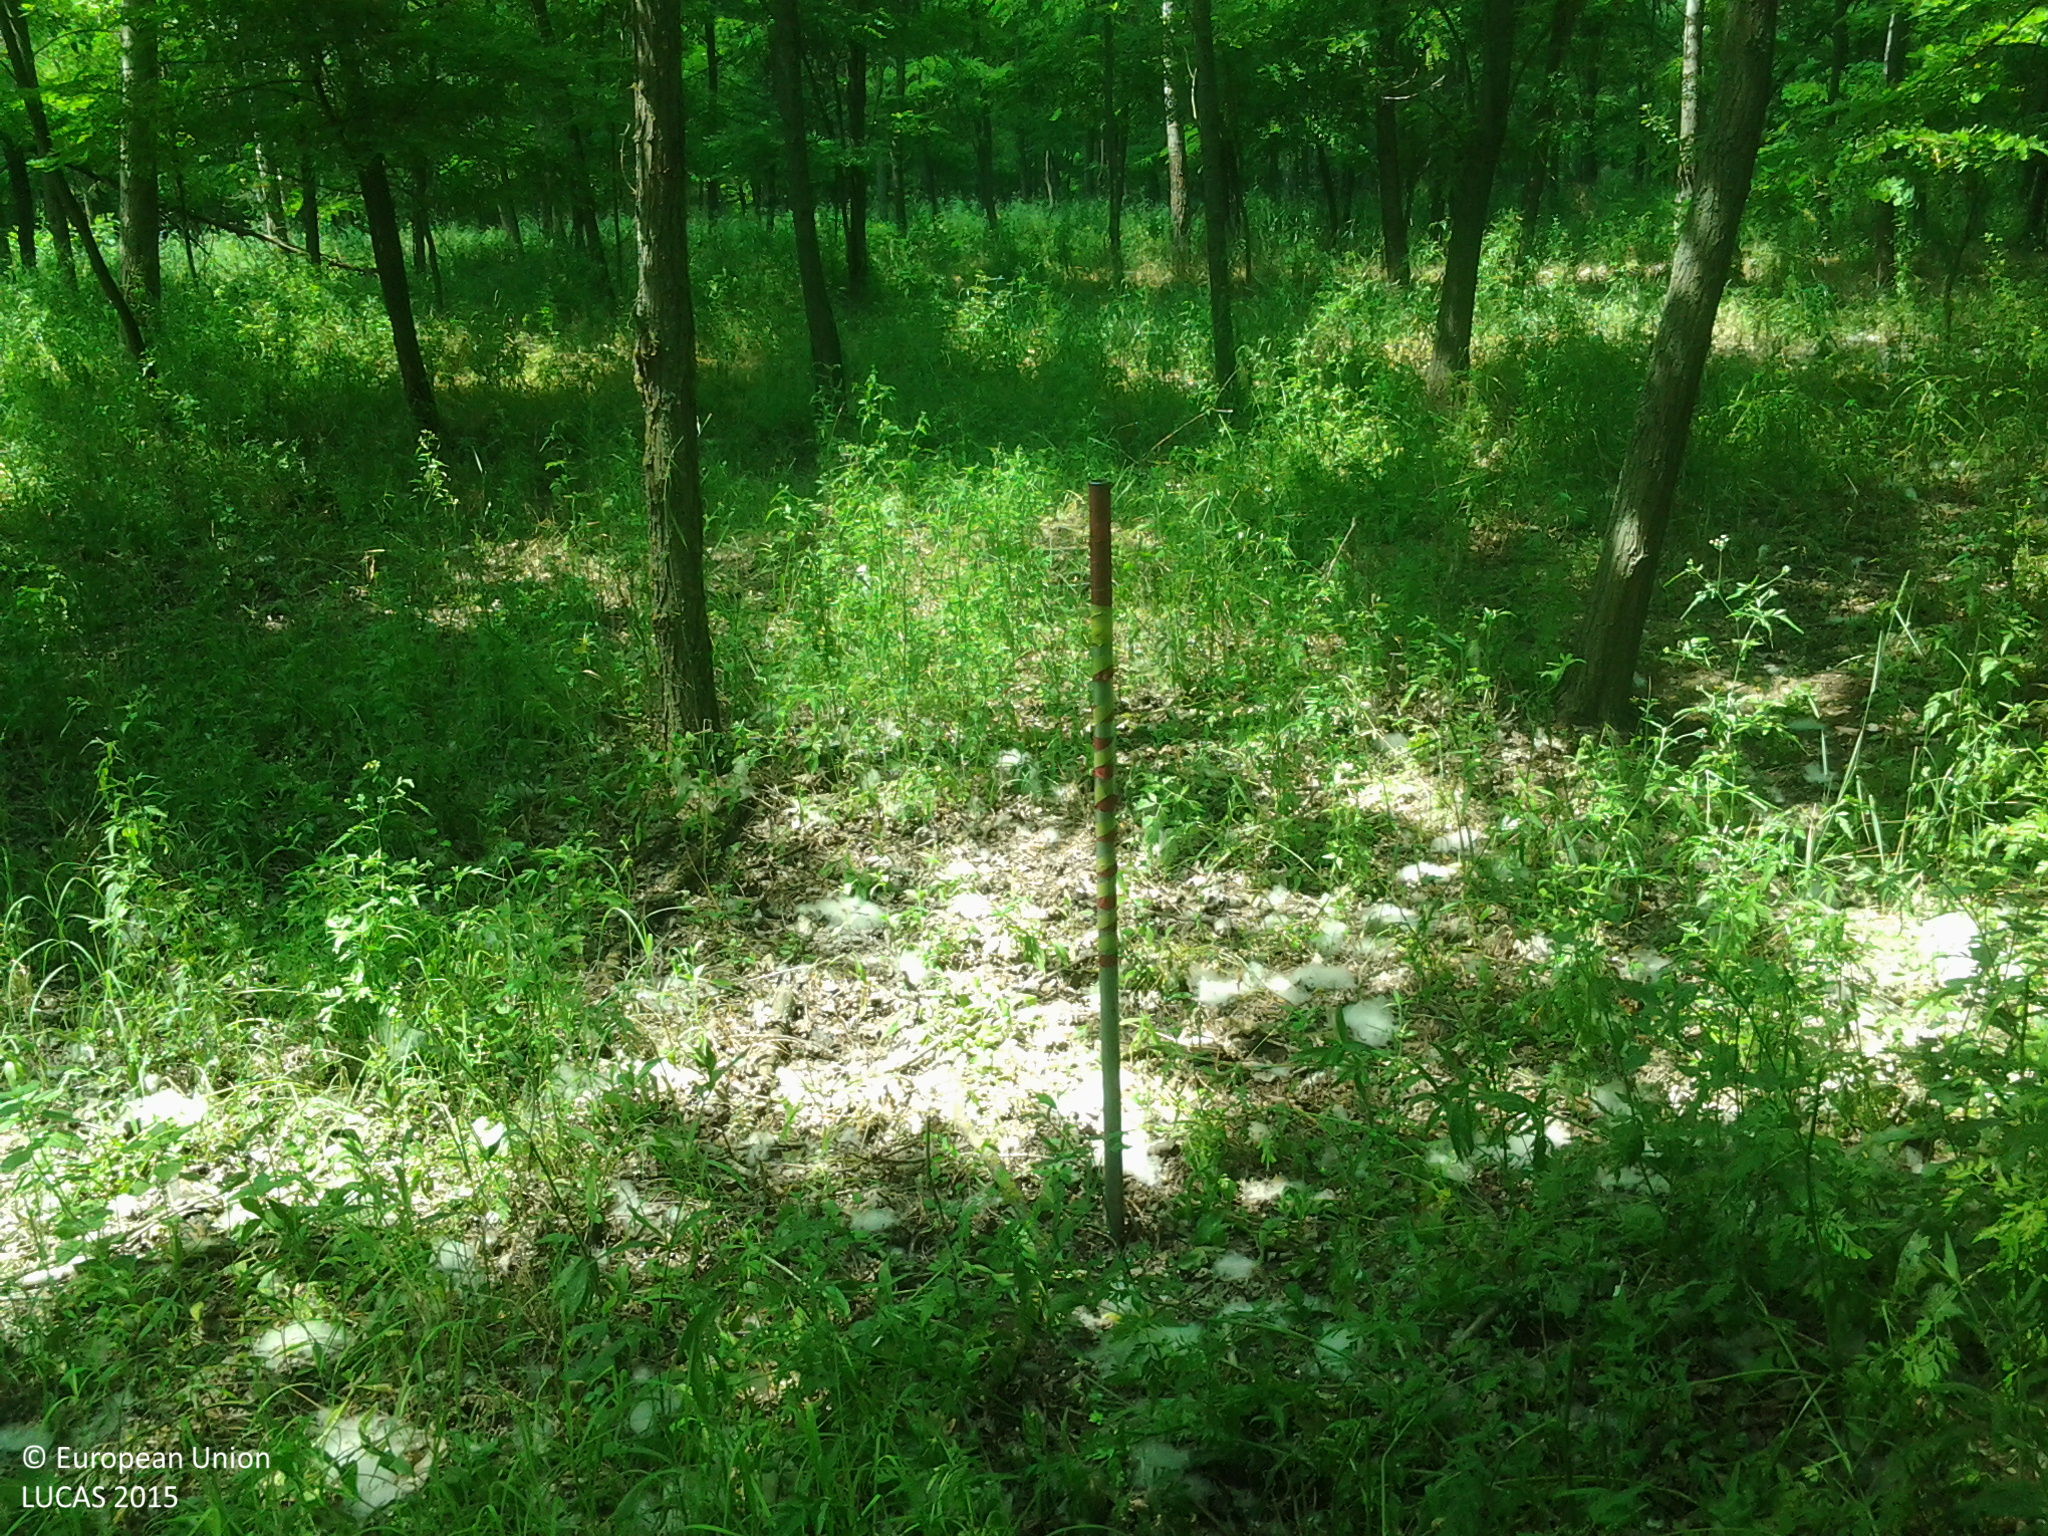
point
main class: Woodland
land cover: Broadleaved woodland
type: mesophytic deciduous forest
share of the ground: 25 - 50 %
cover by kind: broadleaved forest trees 100 %
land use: Forestry
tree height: > 5 m
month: June
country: HU
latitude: 46.7929
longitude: 19.7546
